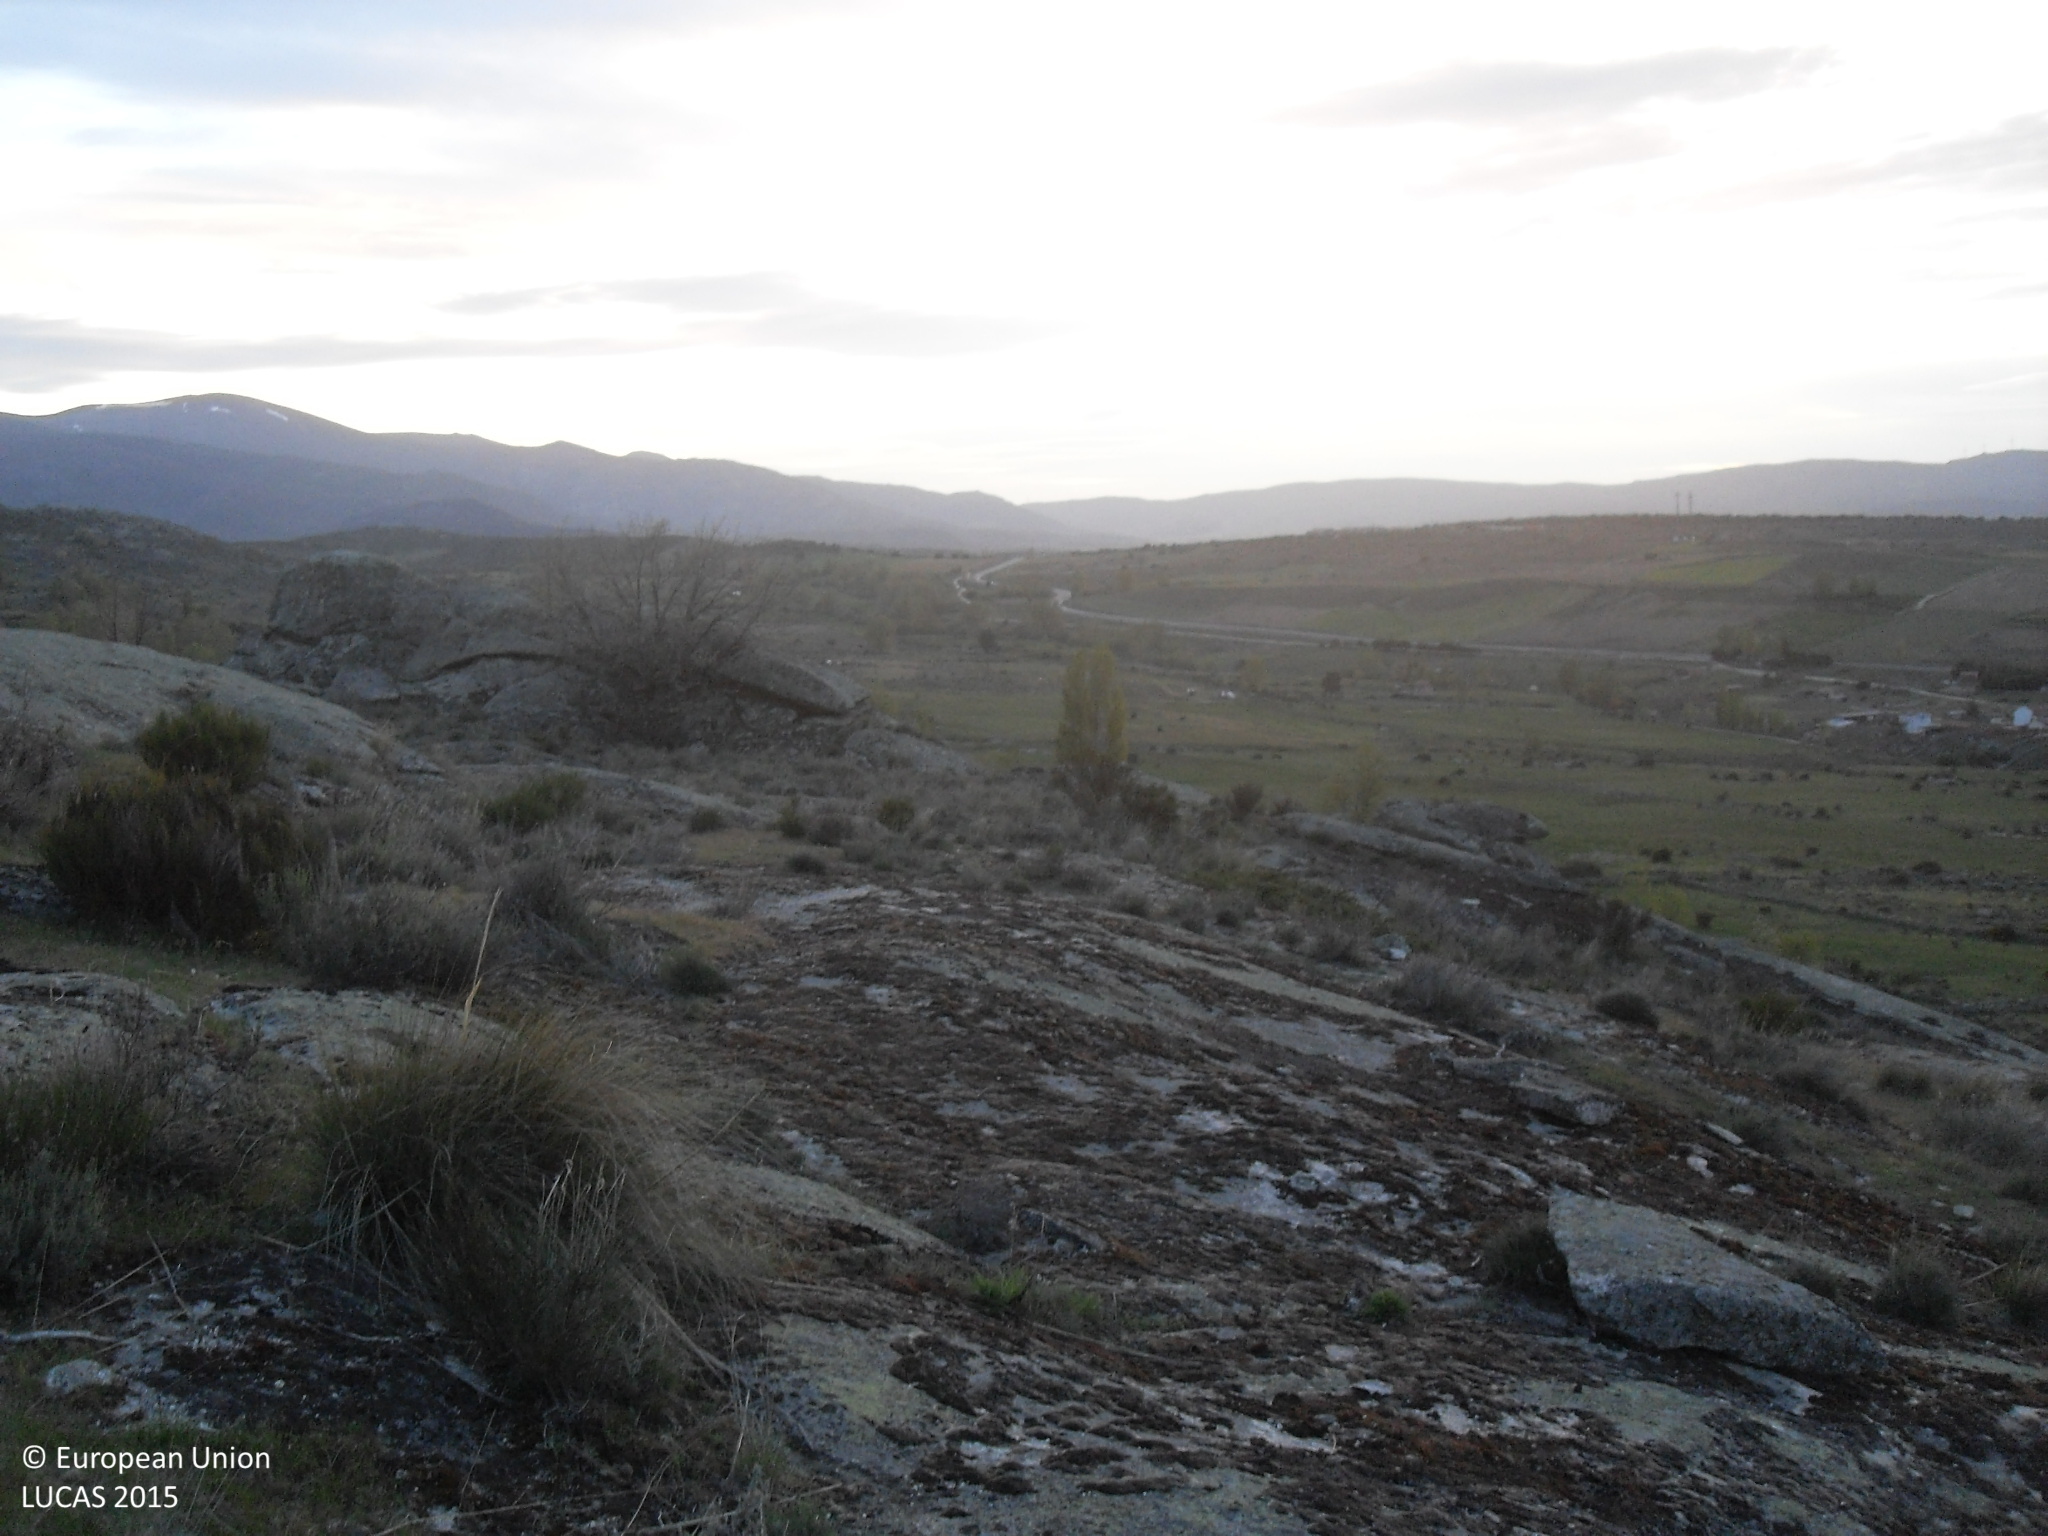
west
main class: Grassland
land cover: Grassland without tree/shrub cover
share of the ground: > 75 %
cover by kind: consolidated bare surface 80 %, herbaceous plants 20 %
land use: Agriculture (excluding fallow land and kitchen gardens)
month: May
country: ES
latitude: 40.5328
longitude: -4.9207
